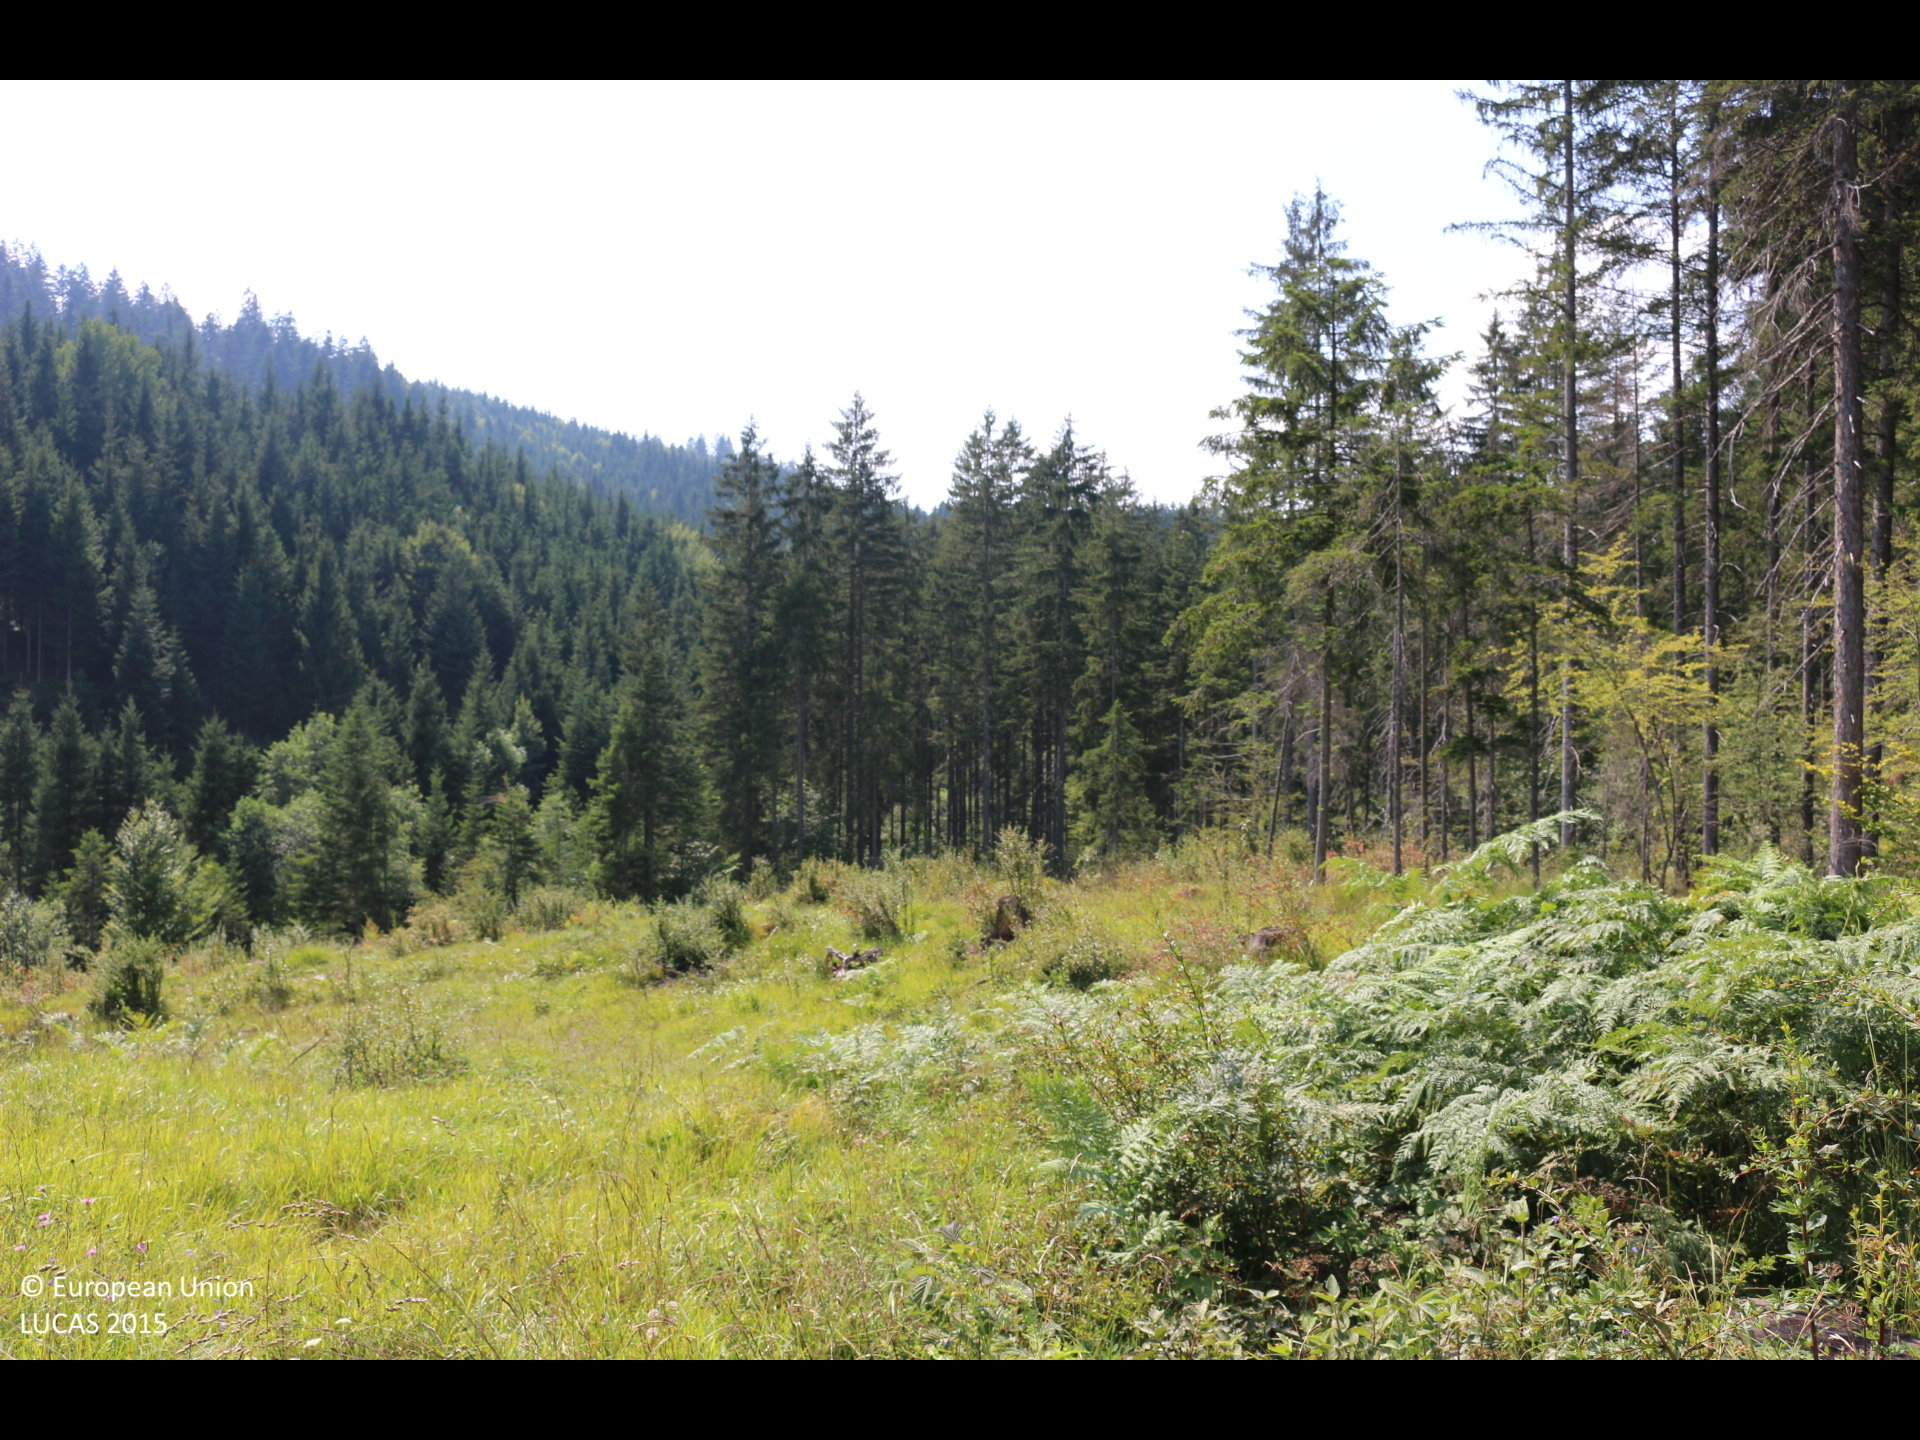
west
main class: Grassland
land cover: Grassland without tree/shrub cover
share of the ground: > 75 %
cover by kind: herbaceous plants 95 %, shrubs 5 %
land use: Forestry
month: August
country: AT
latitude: 46.6403
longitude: 13.3807
